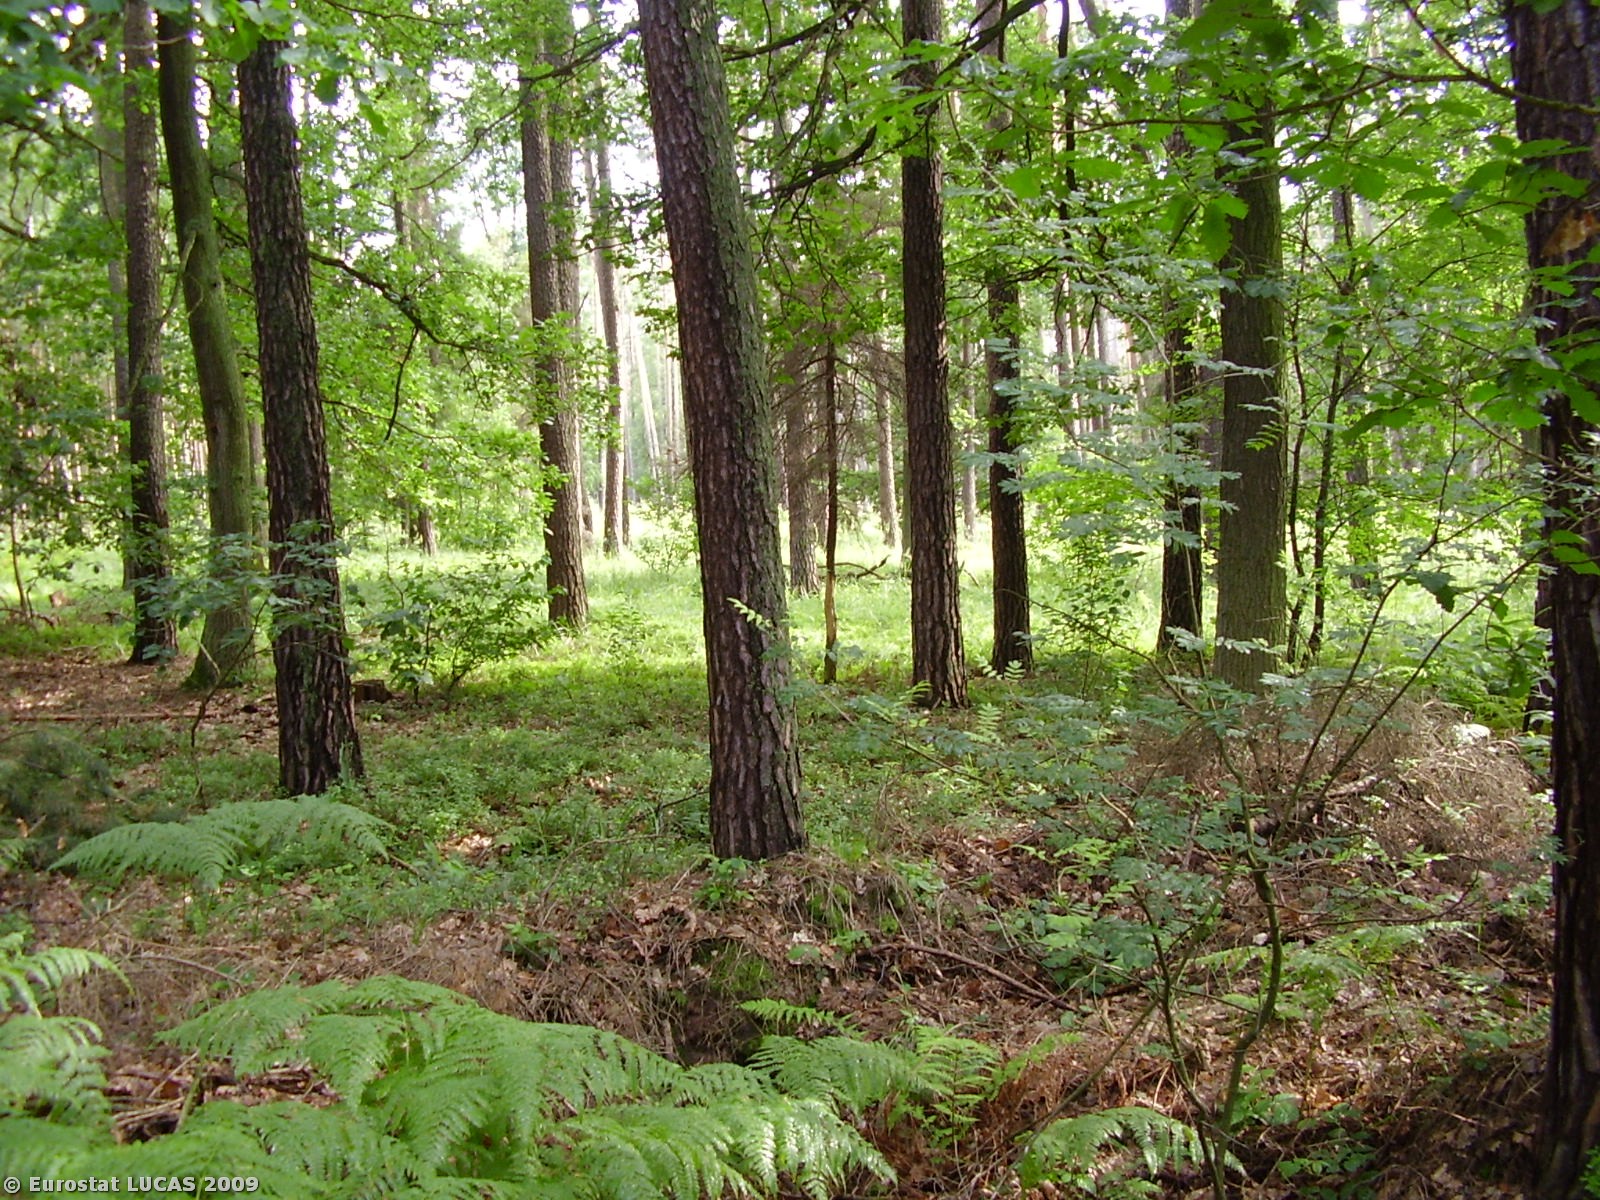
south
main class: Woodland
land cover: Mixed woodland
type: hemiboreal forest and nemoral coniferous forest and mixed broadleaved-coniferous forest
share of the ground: > 75 %
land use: Forestry
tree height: > 5 m
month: July
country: PL
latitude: 51.2086
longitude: 17.9312
